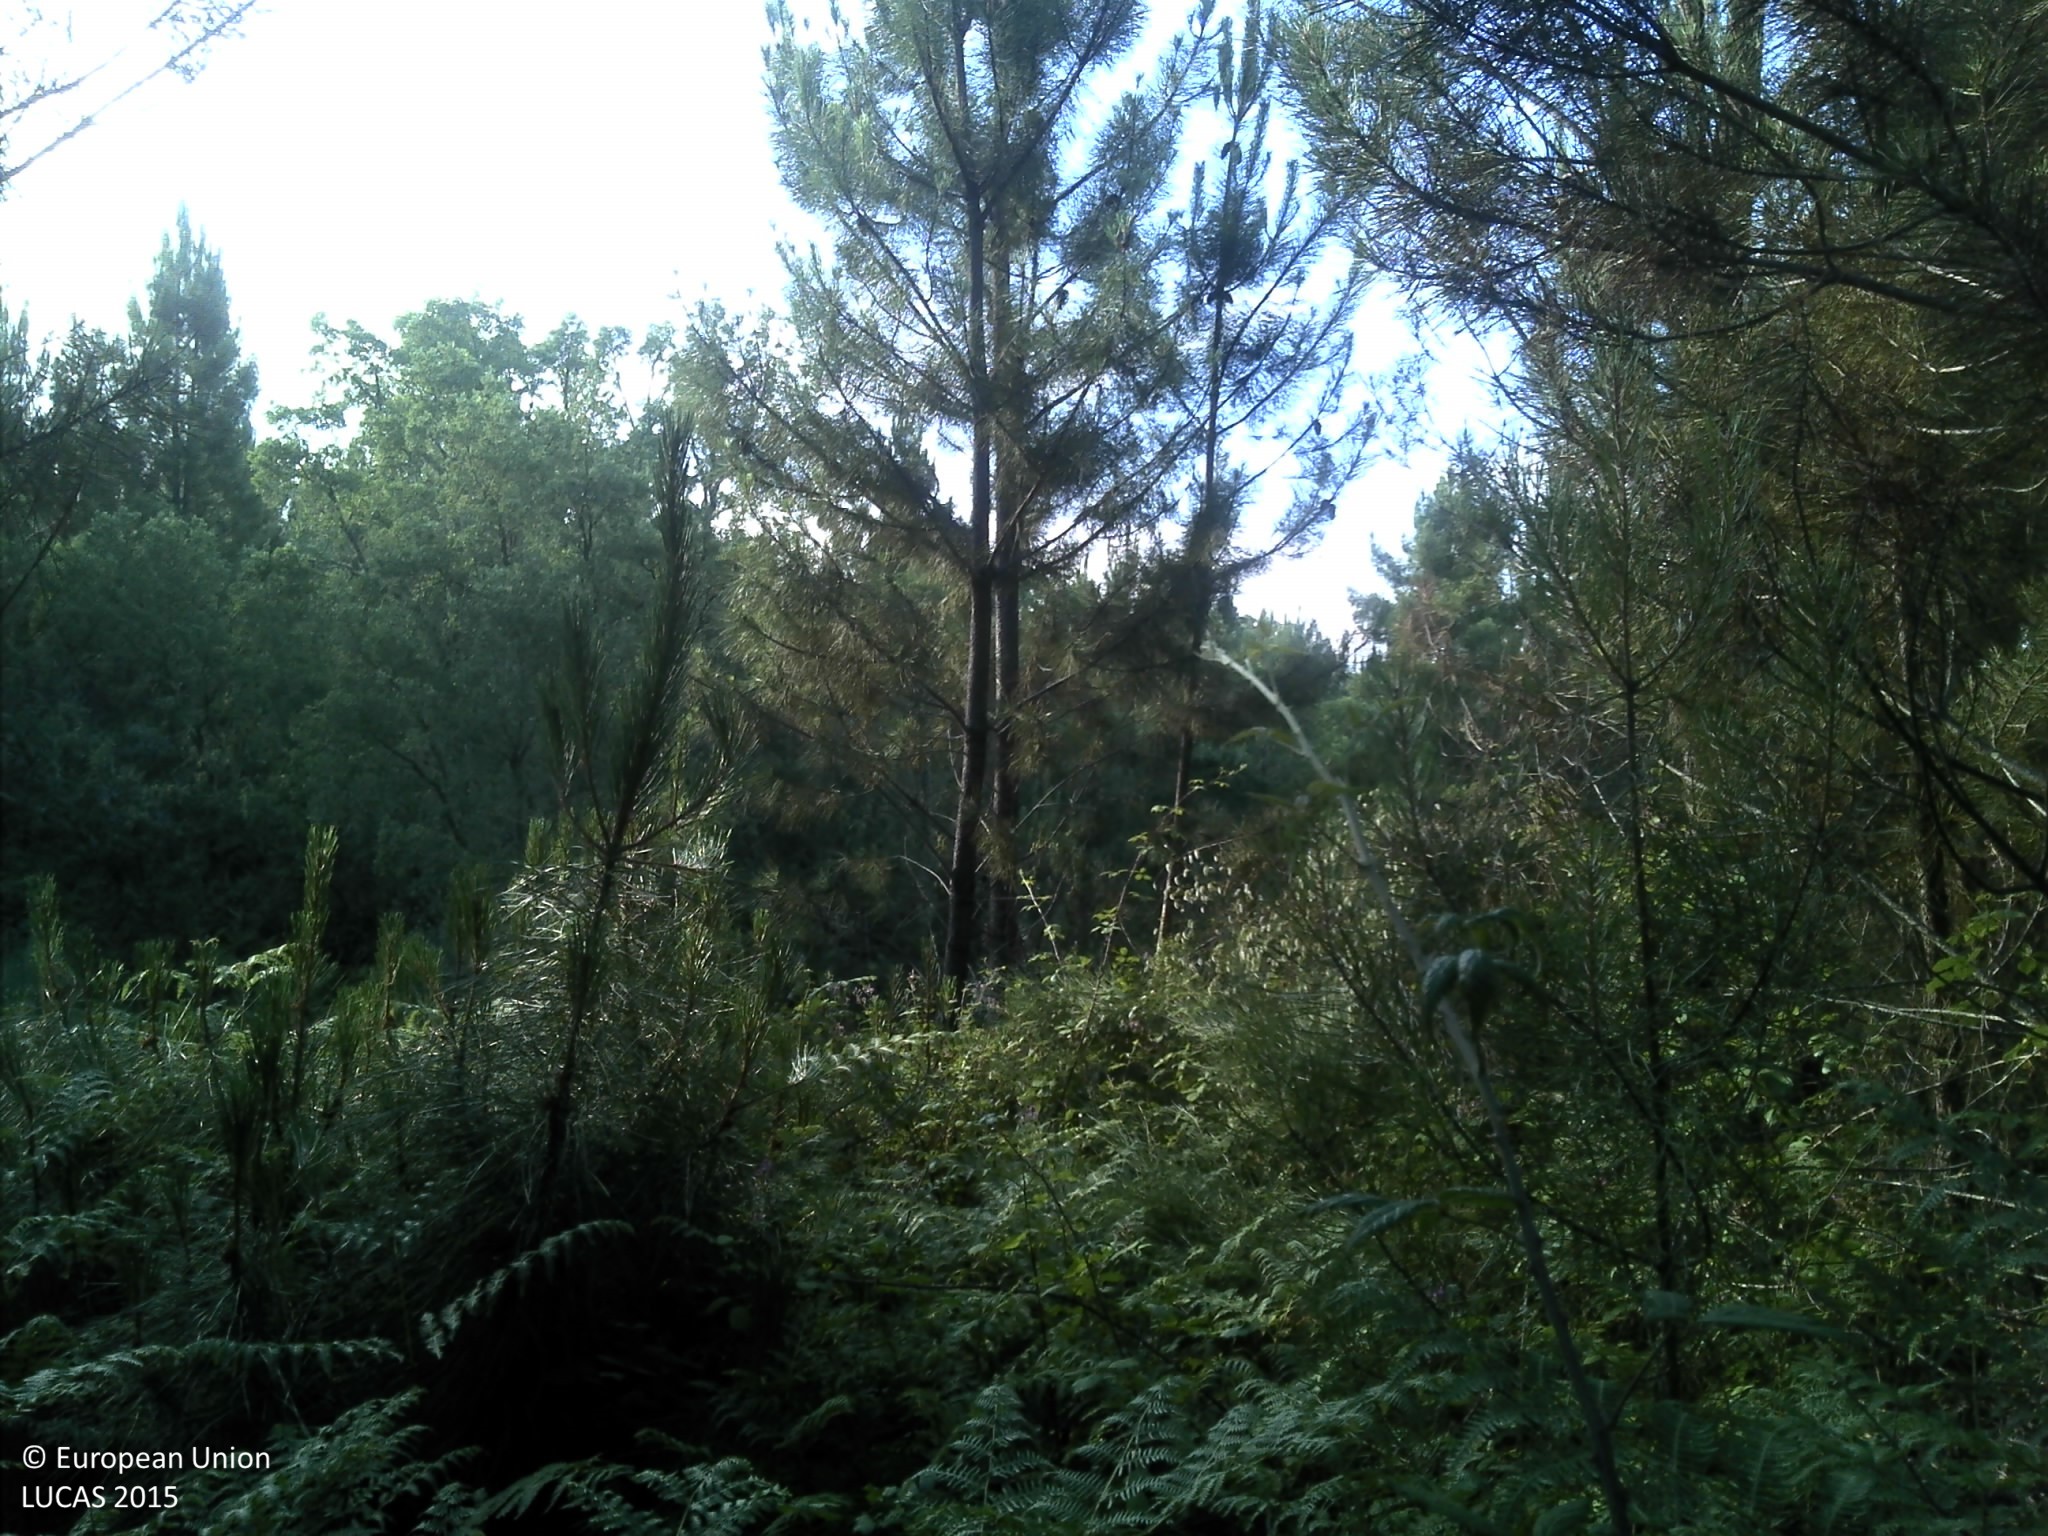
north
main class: Woodland
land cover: Pine dominated mixed woodland
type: coniferous forest of the mediterranean region
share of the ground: 25 - 50 %
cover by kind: coniferous forest trees 50 %, broadleaved forest trees 25 %, shrubs 20 %, unconsolidated bare surface 5 %
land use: Forestry
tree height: < 5 m
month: June
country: PT
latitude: 39.4308
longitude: -7.9356
